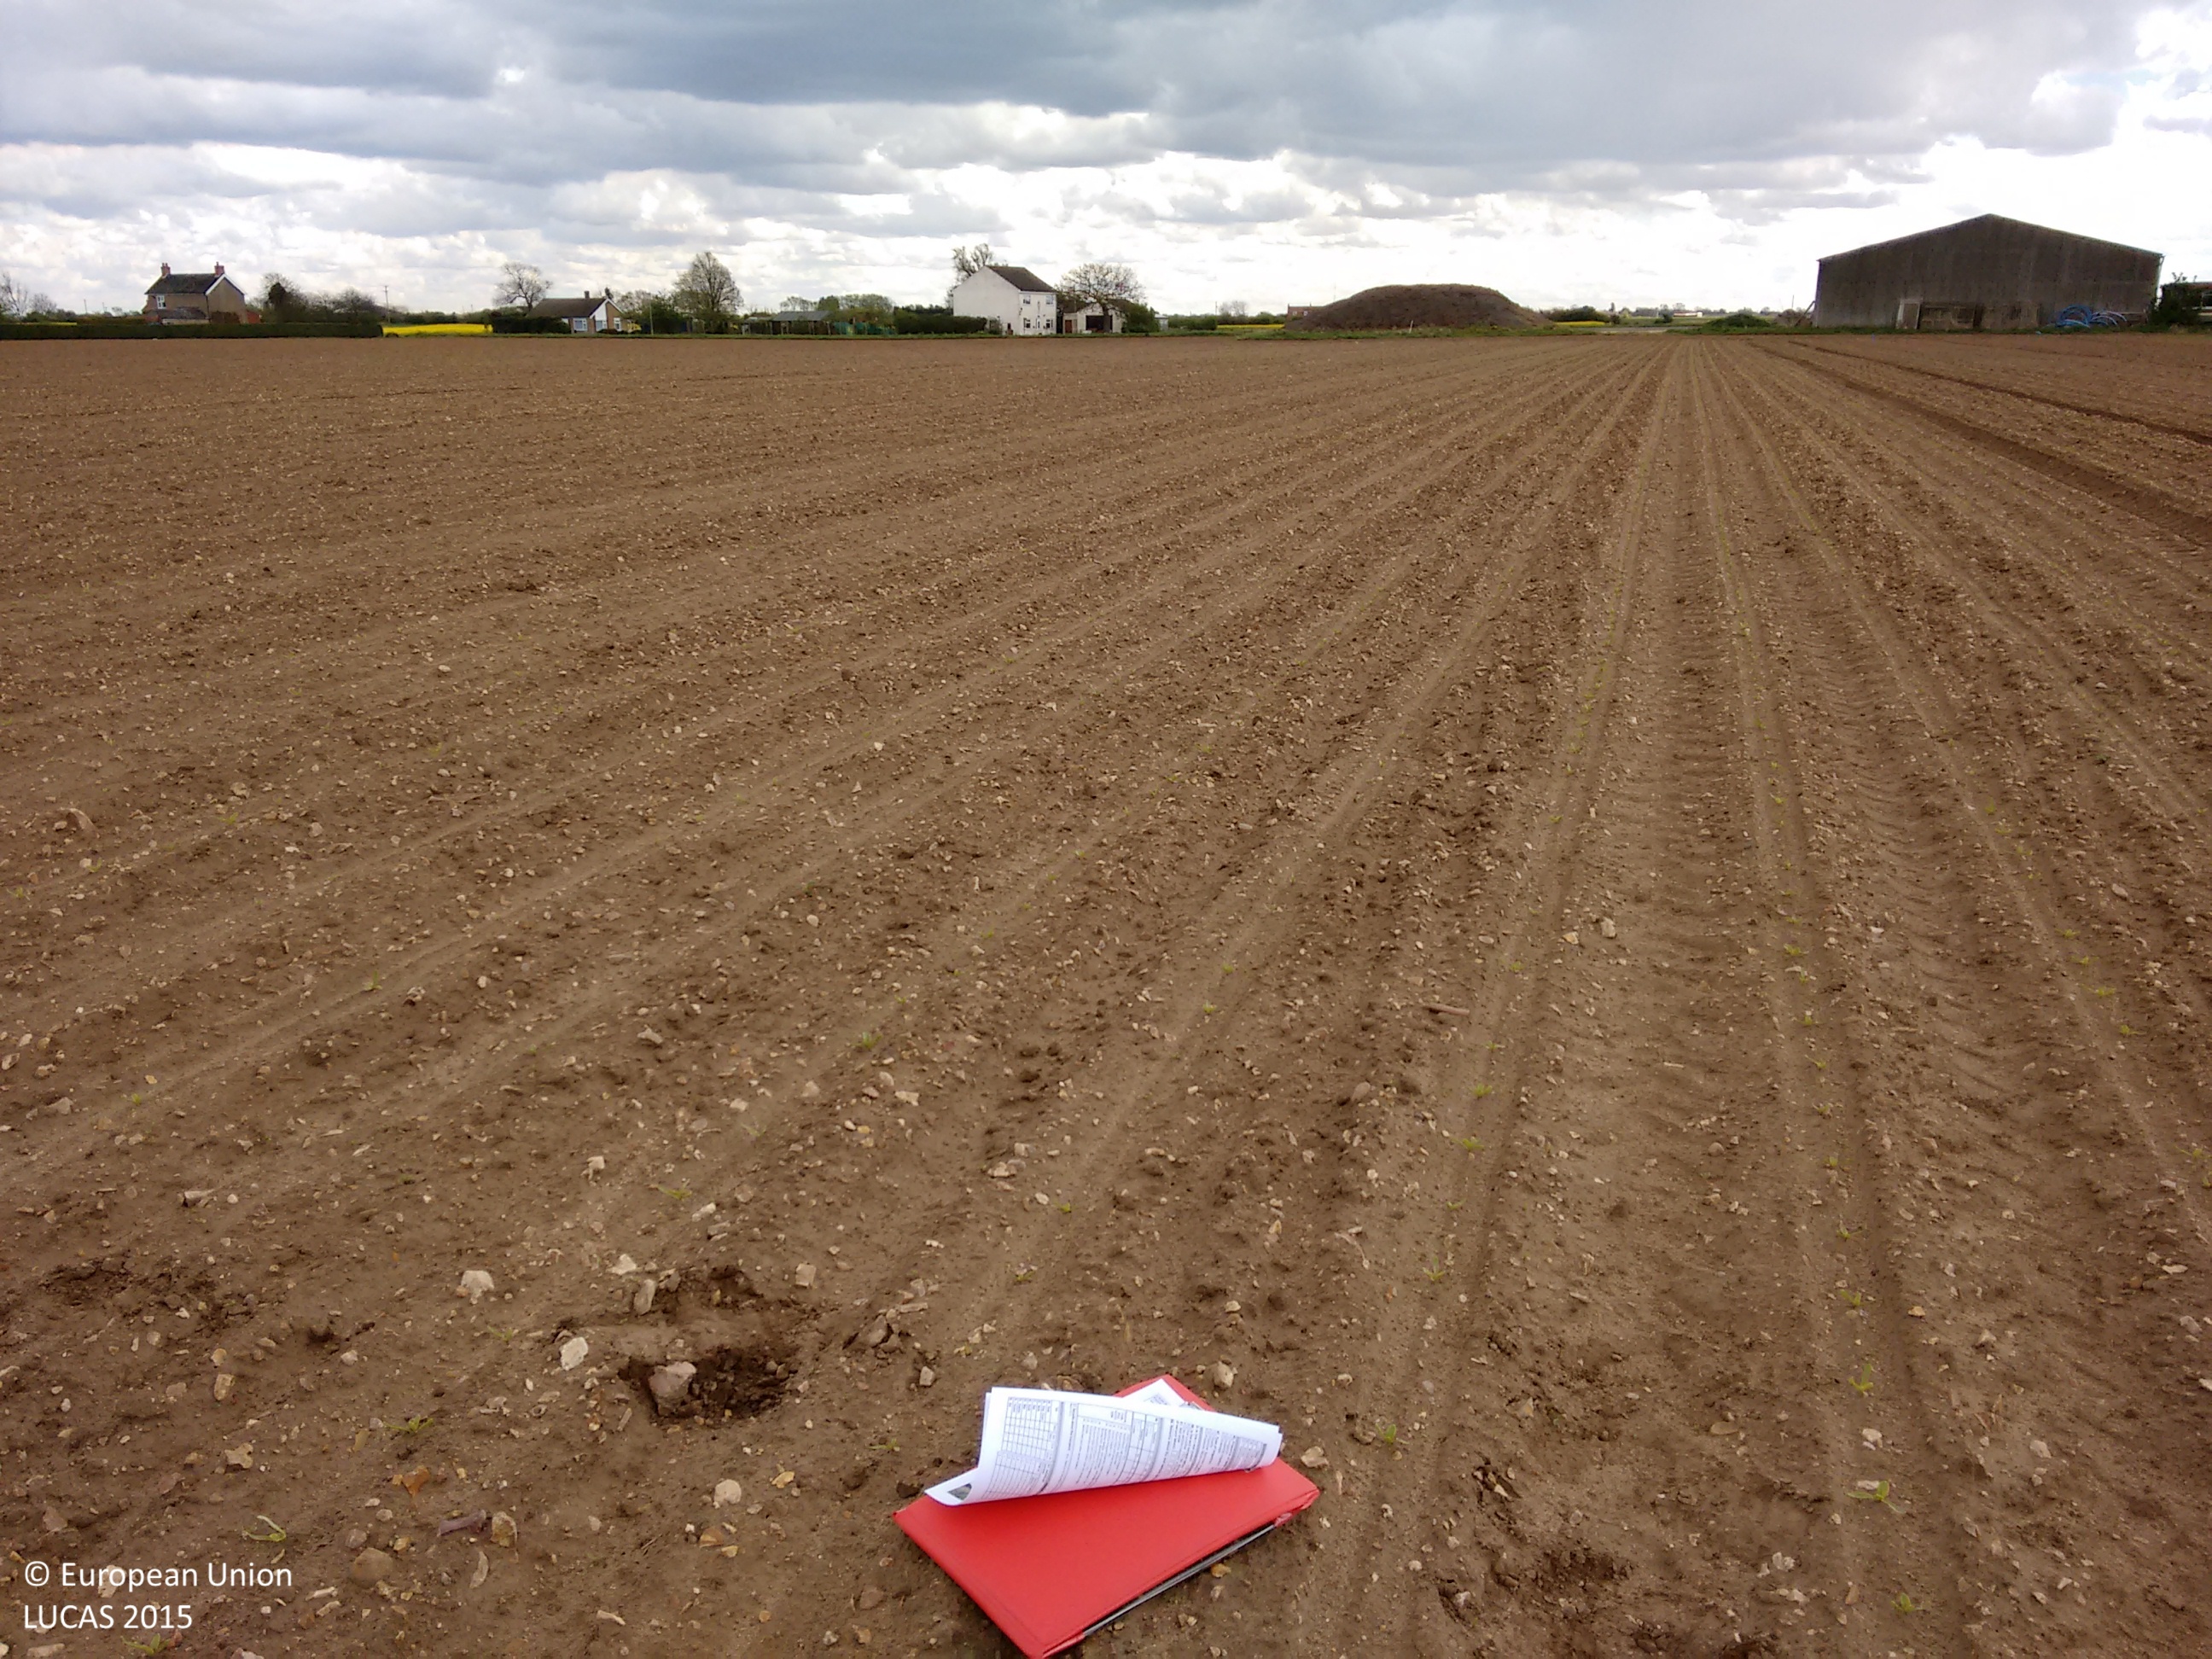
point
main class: Cropland
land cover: Other fresh vegetables
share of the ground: < 10 %
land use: Agriculture (excluding fallow land and kitchen gardens)
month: April
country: GB
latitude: 53.0814
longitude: -0.1705
